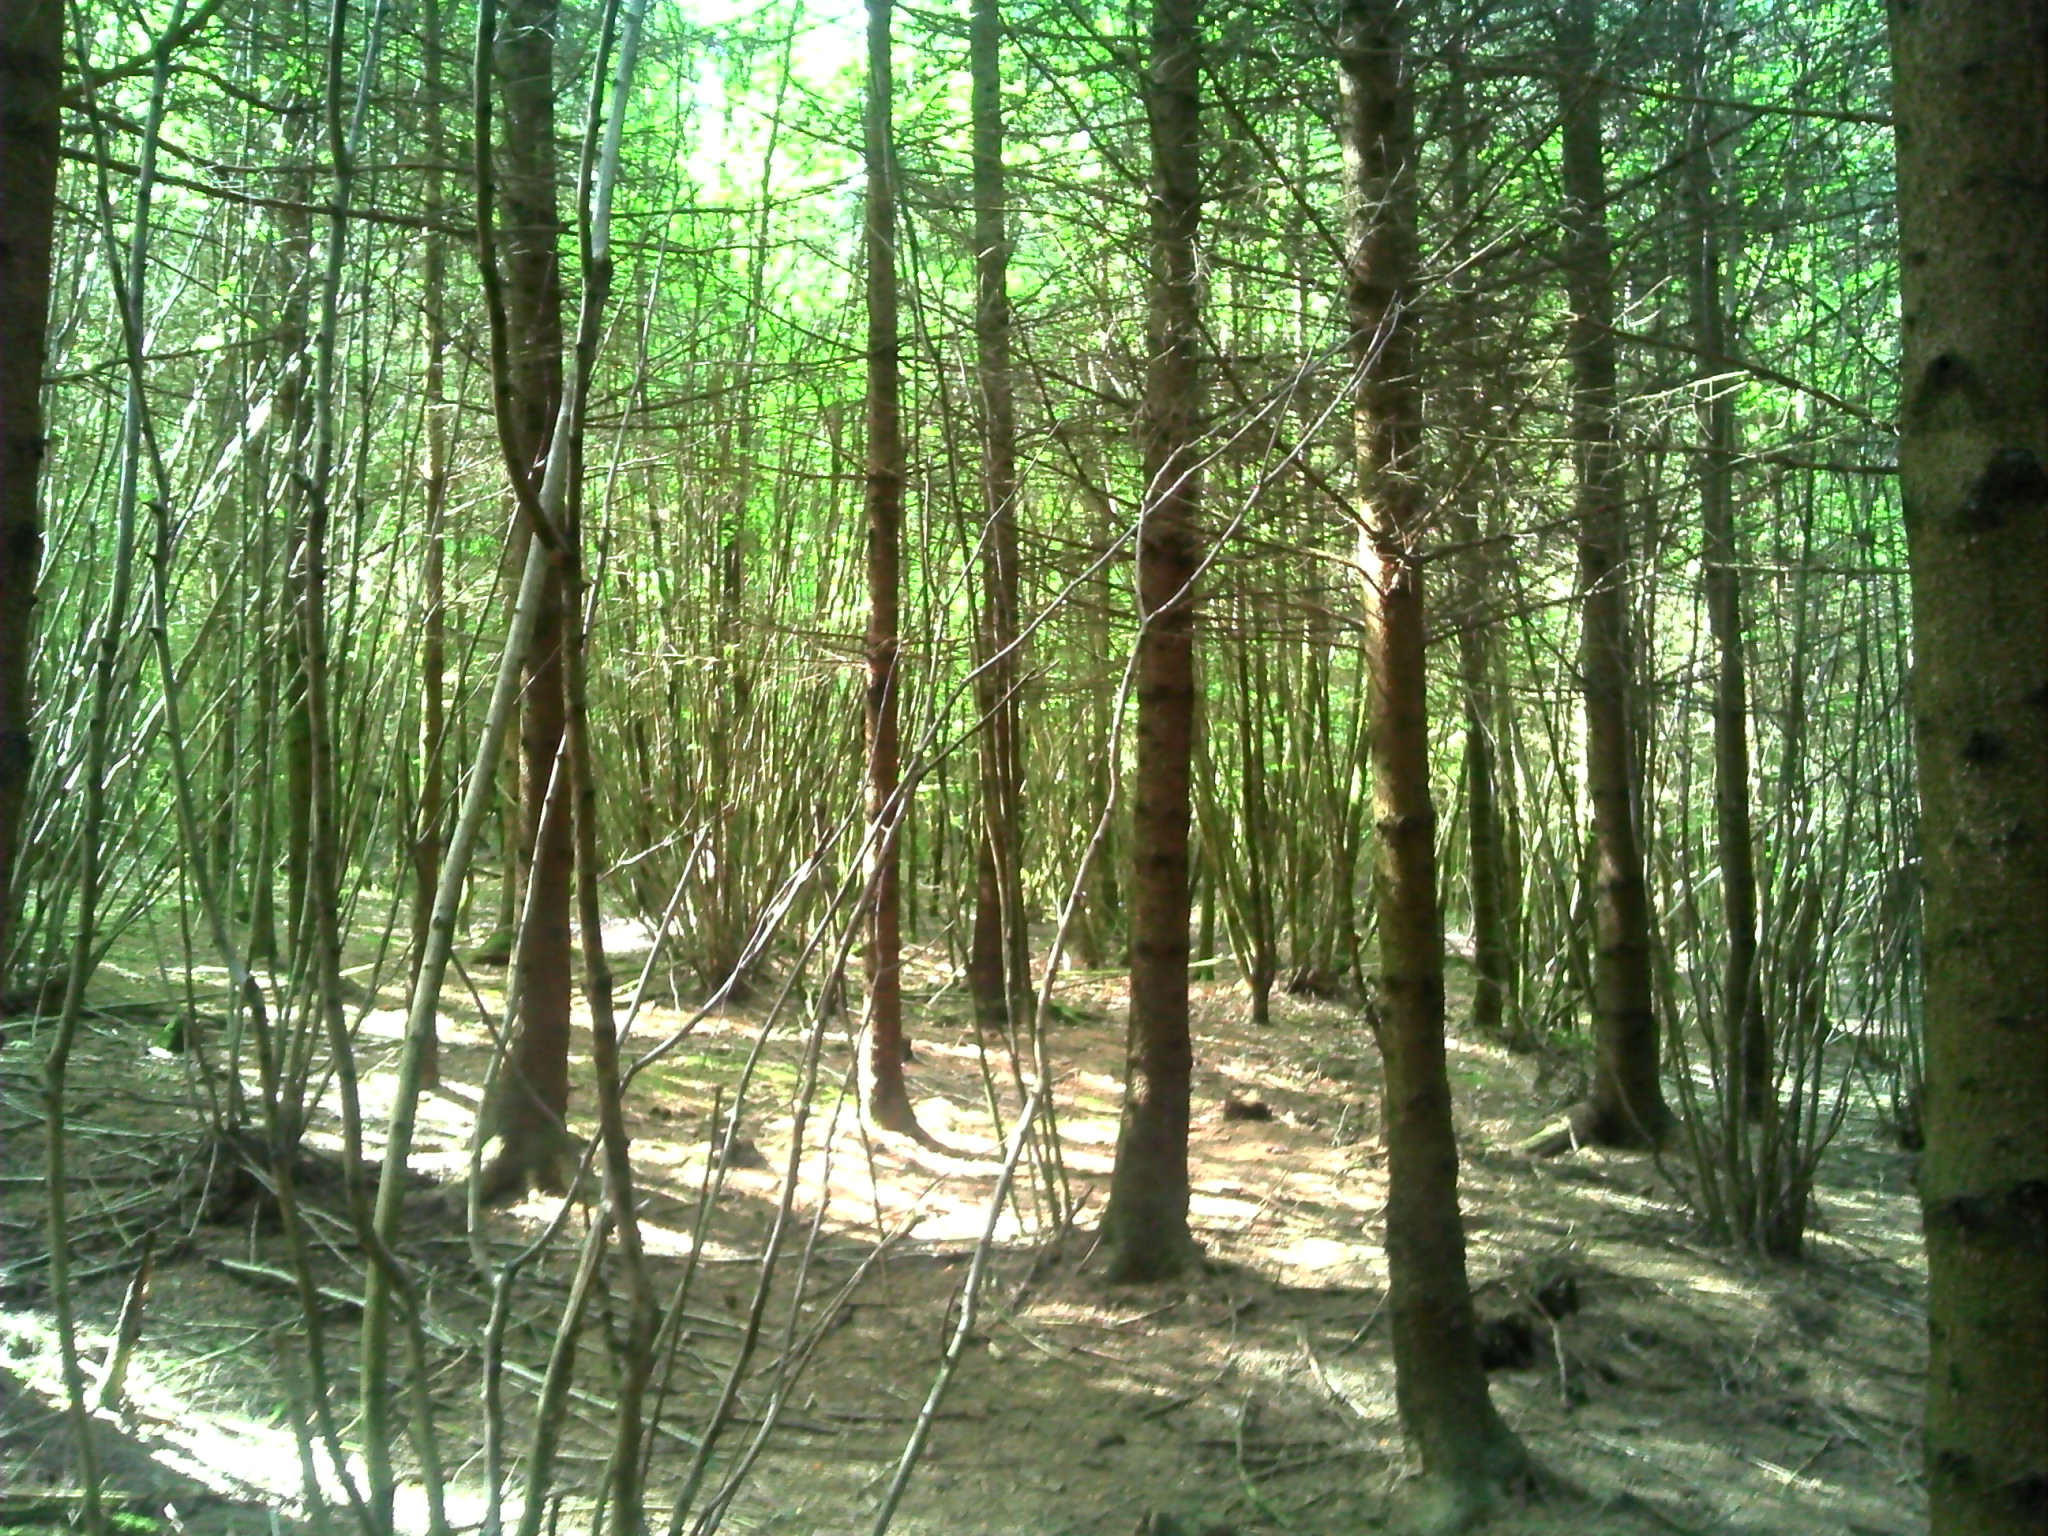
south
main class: Woodland
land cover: Spruce dominated coniferous woodland
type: exotic forest
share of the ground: > 75 %
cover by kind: coniferous forest trees 75 %, broadleaved forest trees 25 %
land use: Forestry
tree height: > 5 m
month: May
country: LU
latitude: 49.9321
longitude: 5.9450
